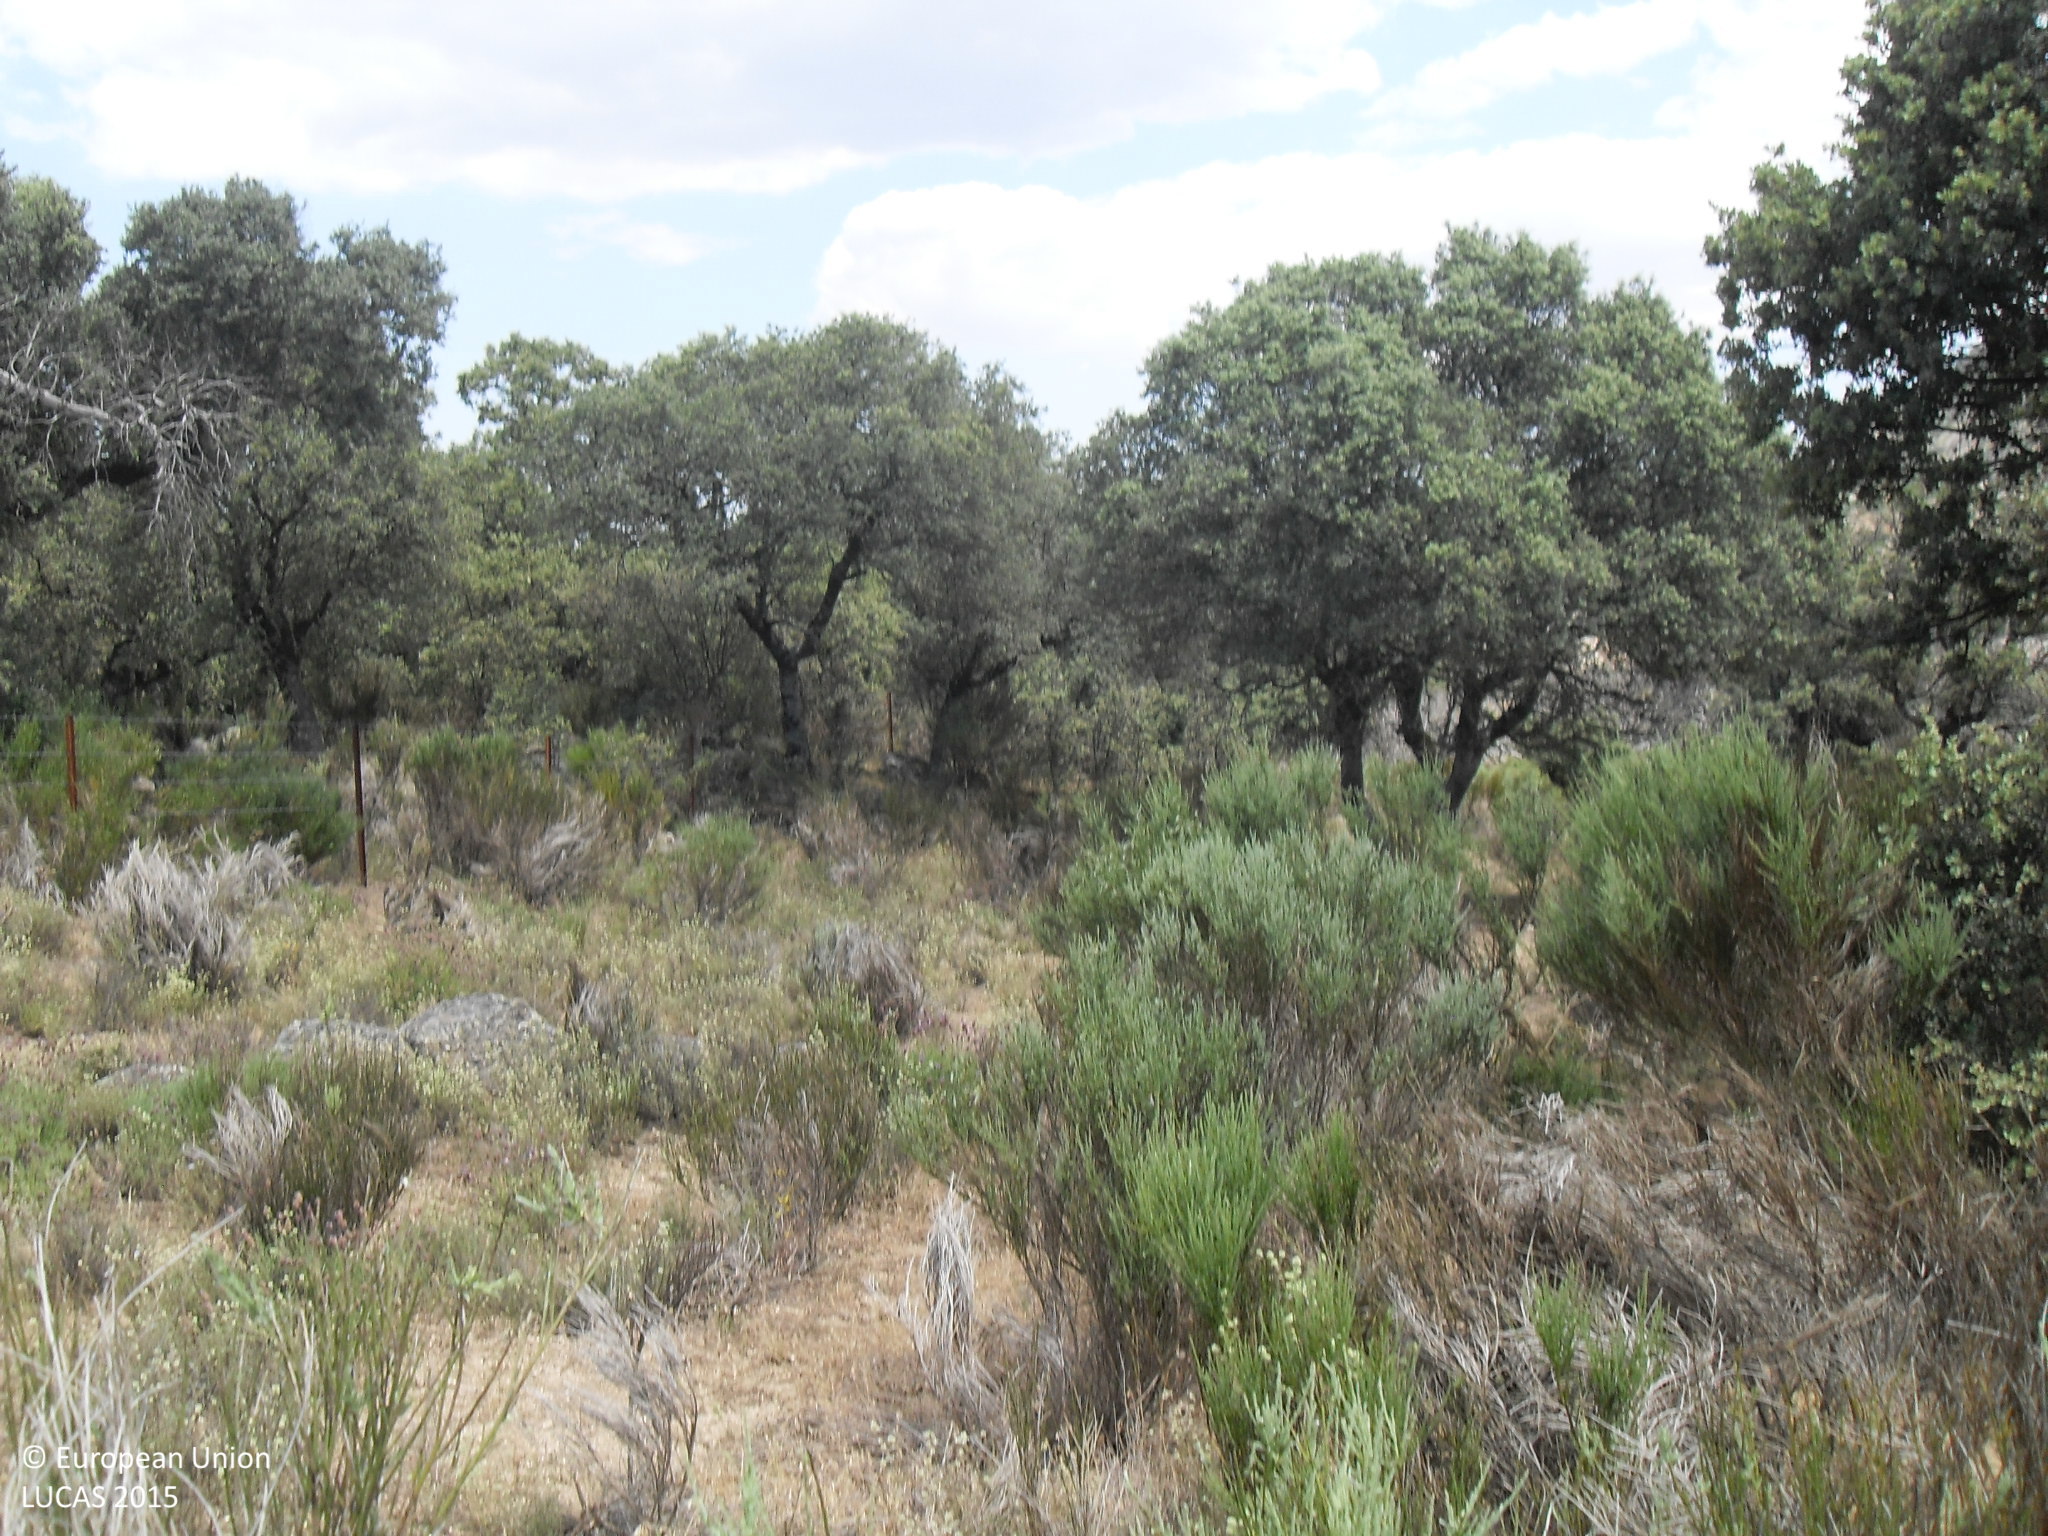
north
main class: Shrubland
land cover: Shrubland without tree cover
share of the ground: > 75 %
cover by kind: shrubs 60 %, herbaceous plants 40 %
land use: Abandoned areas
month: June
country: ES
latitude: 40.4491
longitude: -5.5729
